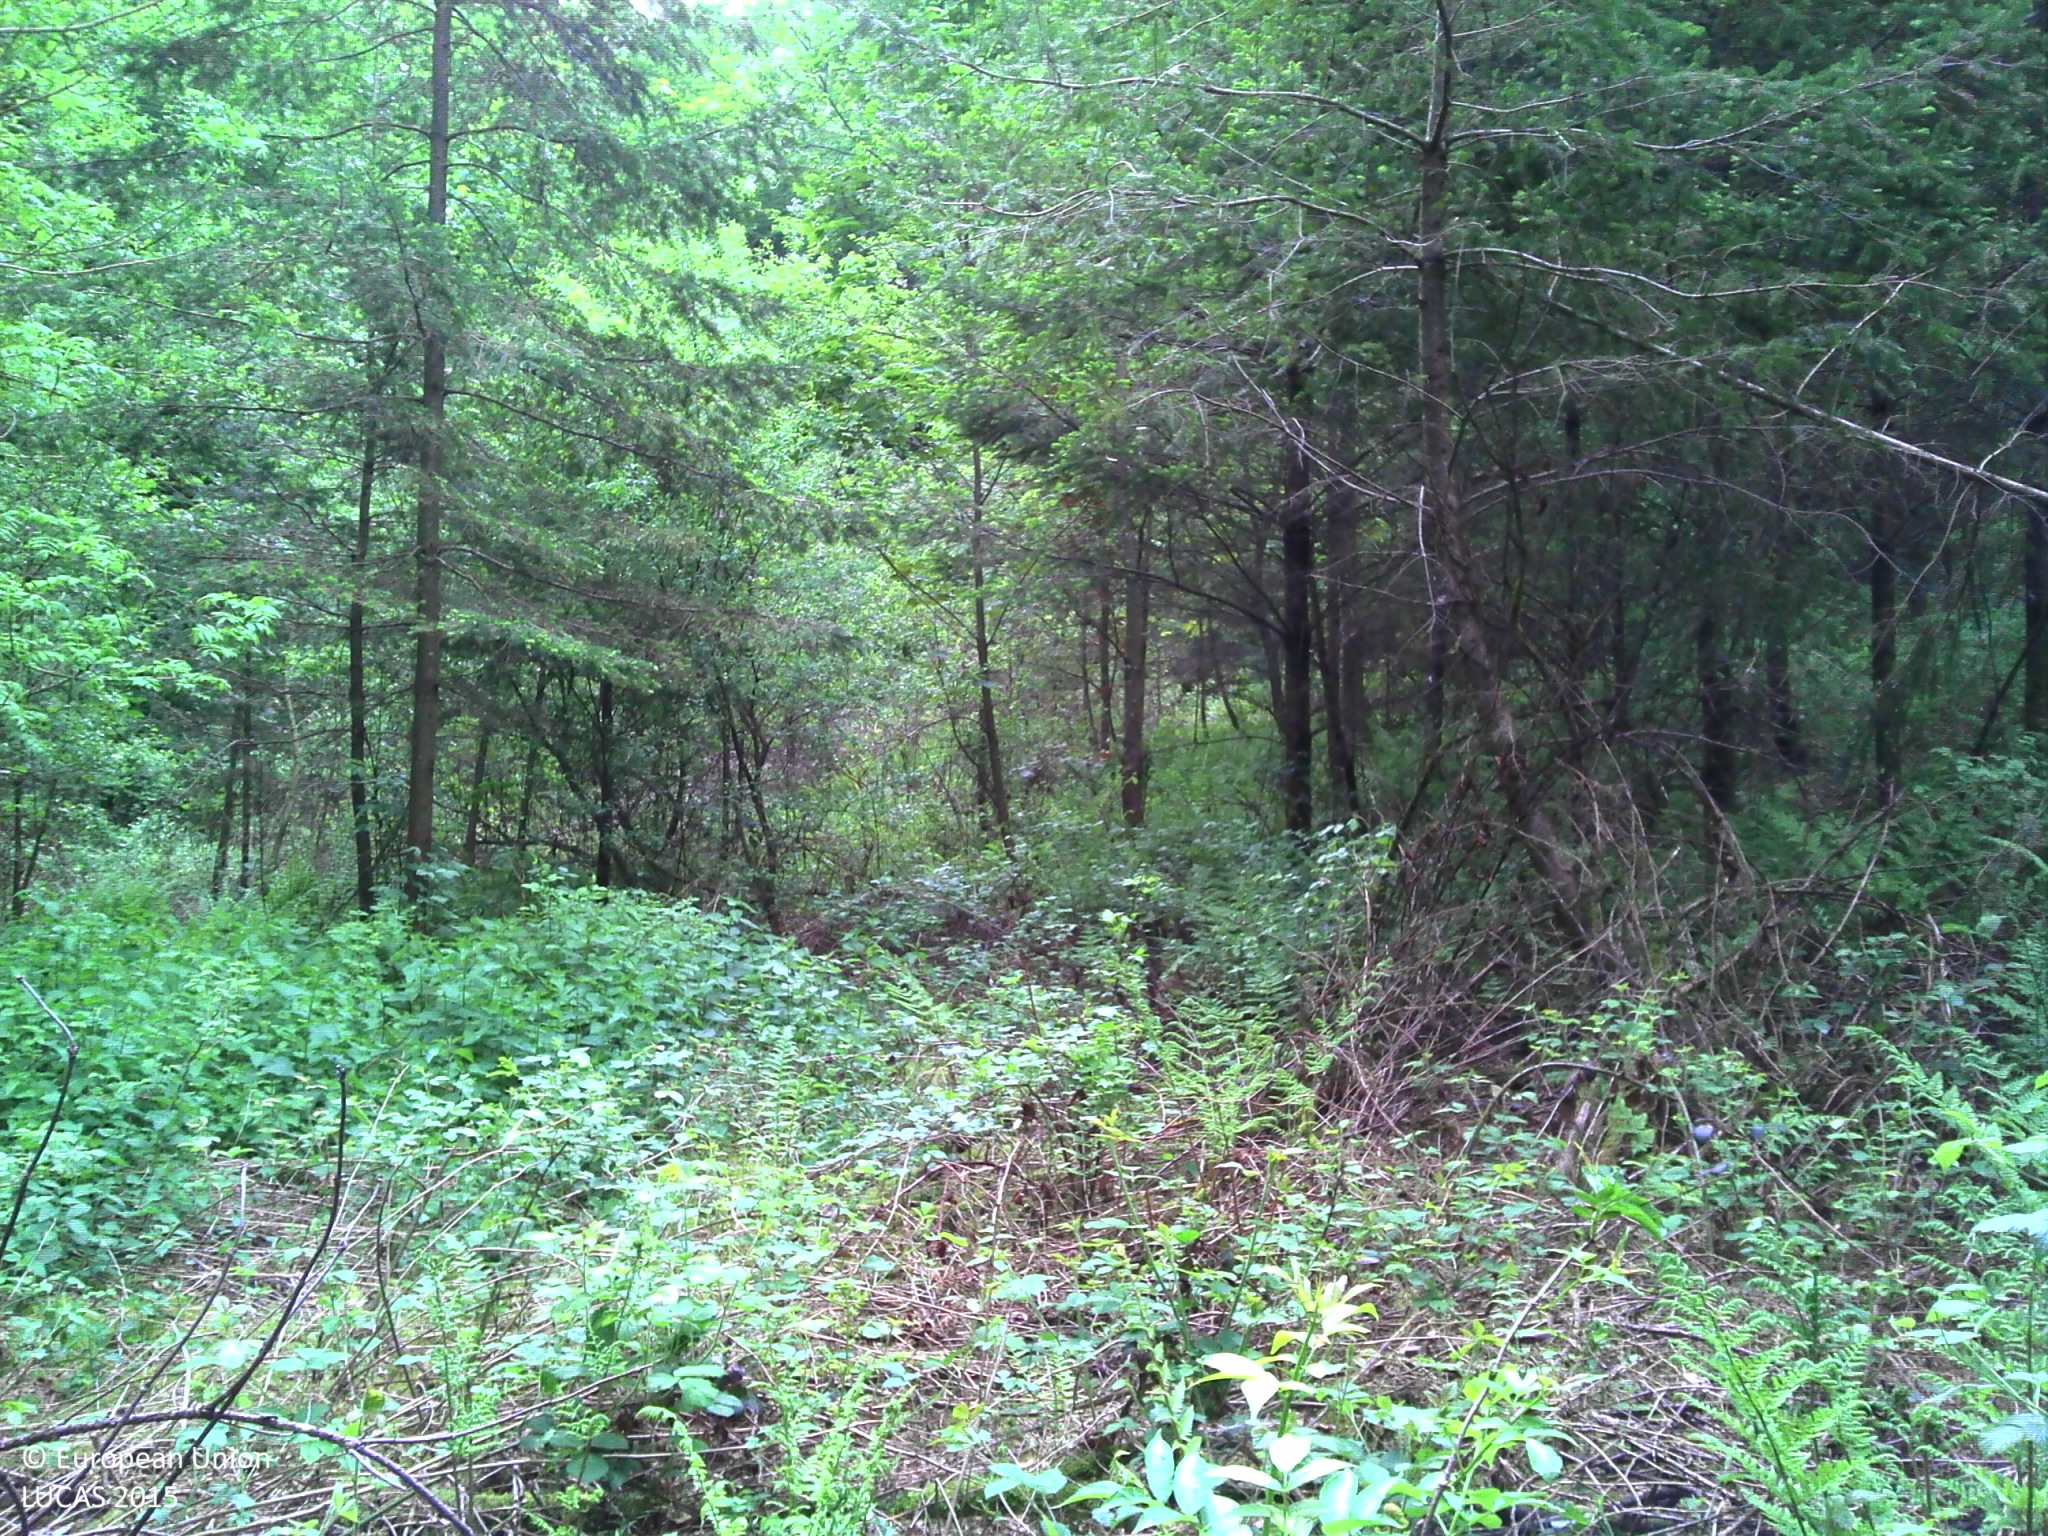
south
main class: Woodland
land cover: Other mixed woodland
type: hemiboreal forest and nemoral coniferous forest and mixed broadleaved-coniferous forest
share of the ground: > 75 %
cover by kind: broadleaved forest trees 60 %, coniferous forest trees 40 %
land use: Forestry
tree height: > 5 m
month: May
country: LU
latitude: 49.6827
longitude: 6.0215
